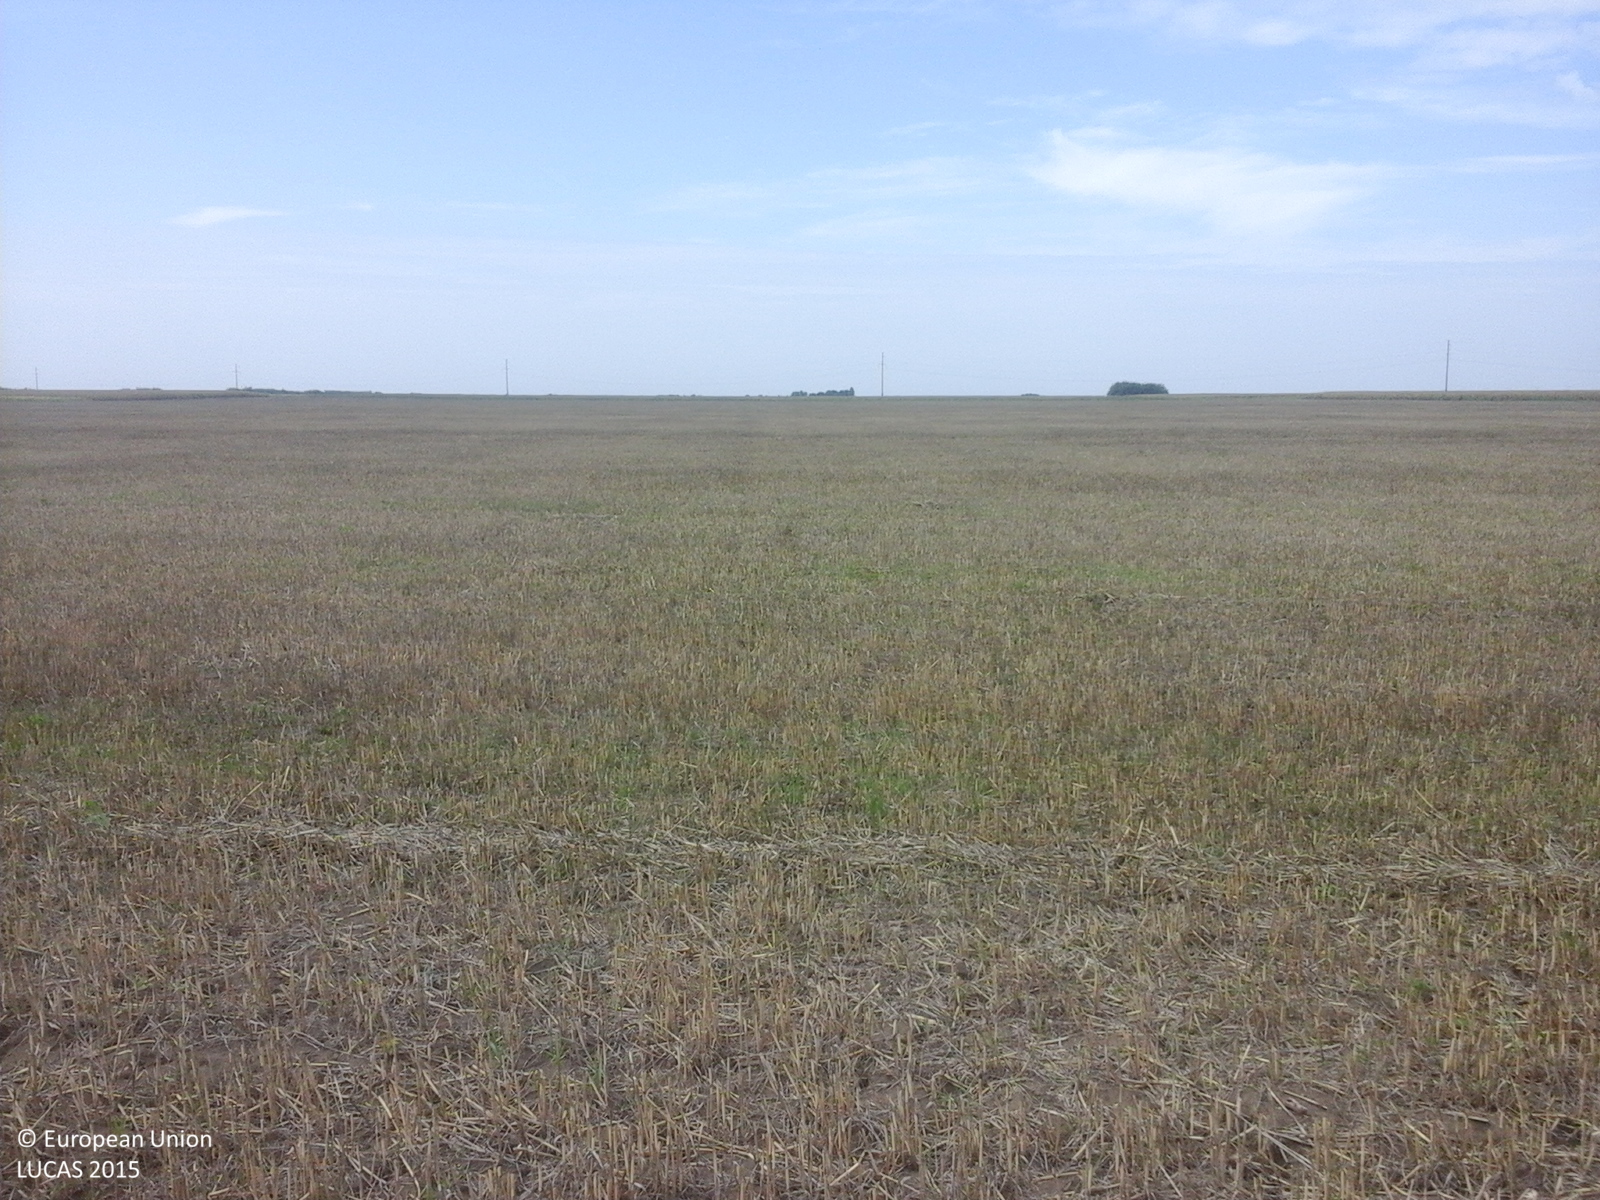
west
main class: Cropland
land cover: Common wheat
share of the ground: 25 - 50 %
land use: Agriculture (excluding fallow land and kitchen gardens)
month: August
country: RO
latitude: 46.4608
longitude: 21.4564
